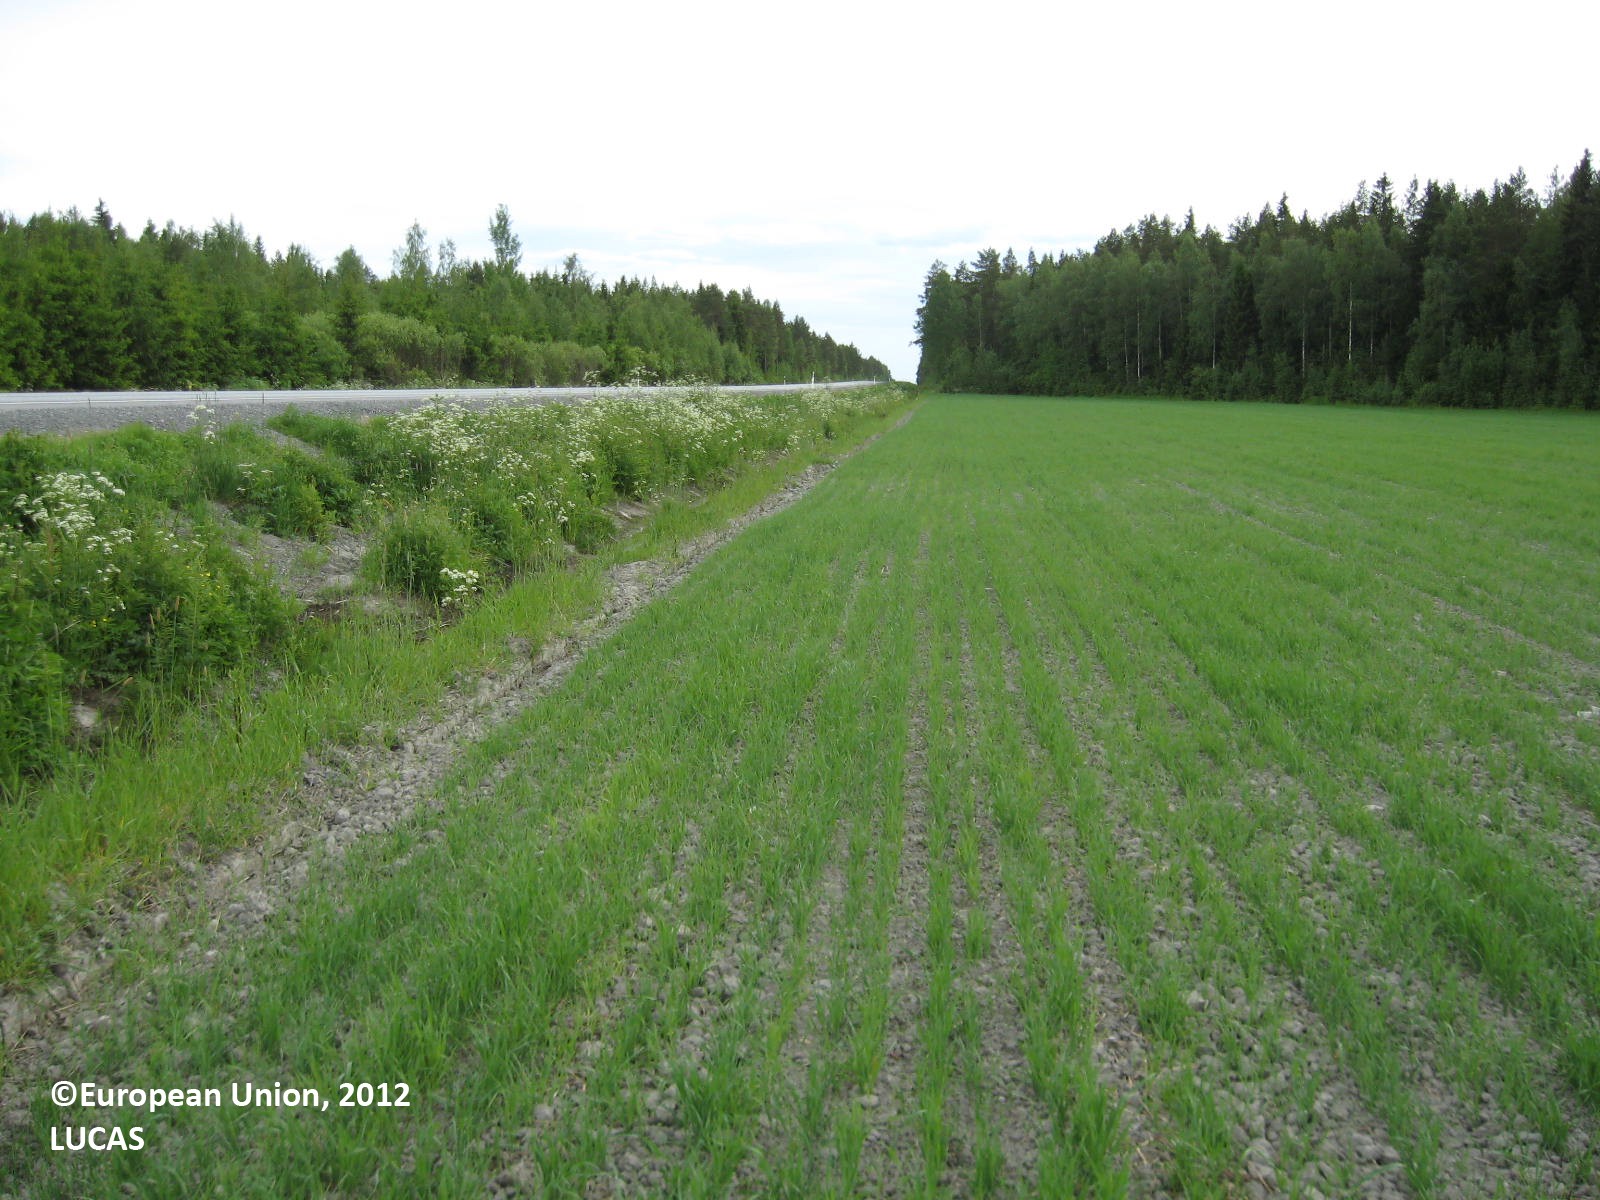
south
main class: Cropland
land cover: Oats
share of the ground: 50 - 75 %
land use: Agriculture (excluding fallow land and kitchen gardens)
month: June
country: FI
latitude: 62.6248
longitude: 21.5247
